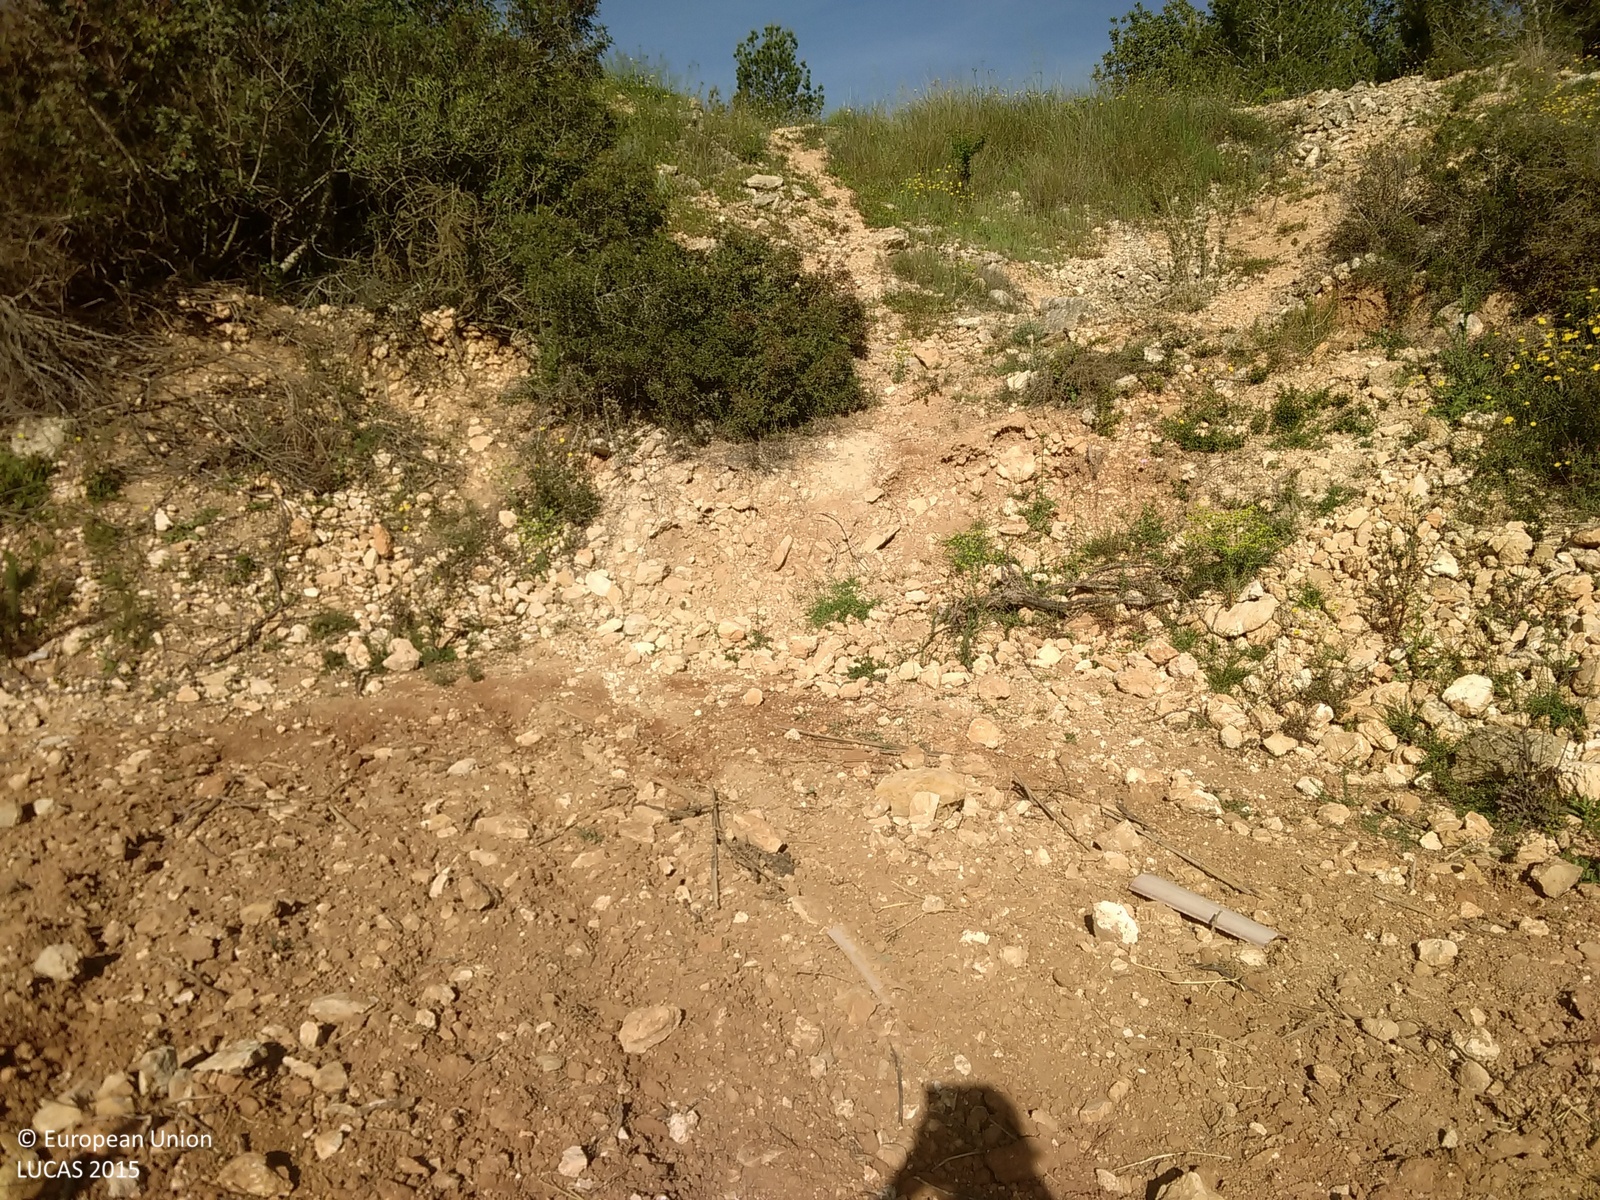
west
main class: Cropland
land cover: Vineyards
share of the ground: 10 - 25 %
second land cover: Other bare soil
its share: > 75 %
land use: Agriculture (excluding fallow land and kitchen gardens)
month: April
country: ES
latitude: 39.4279
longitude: -0.6742
